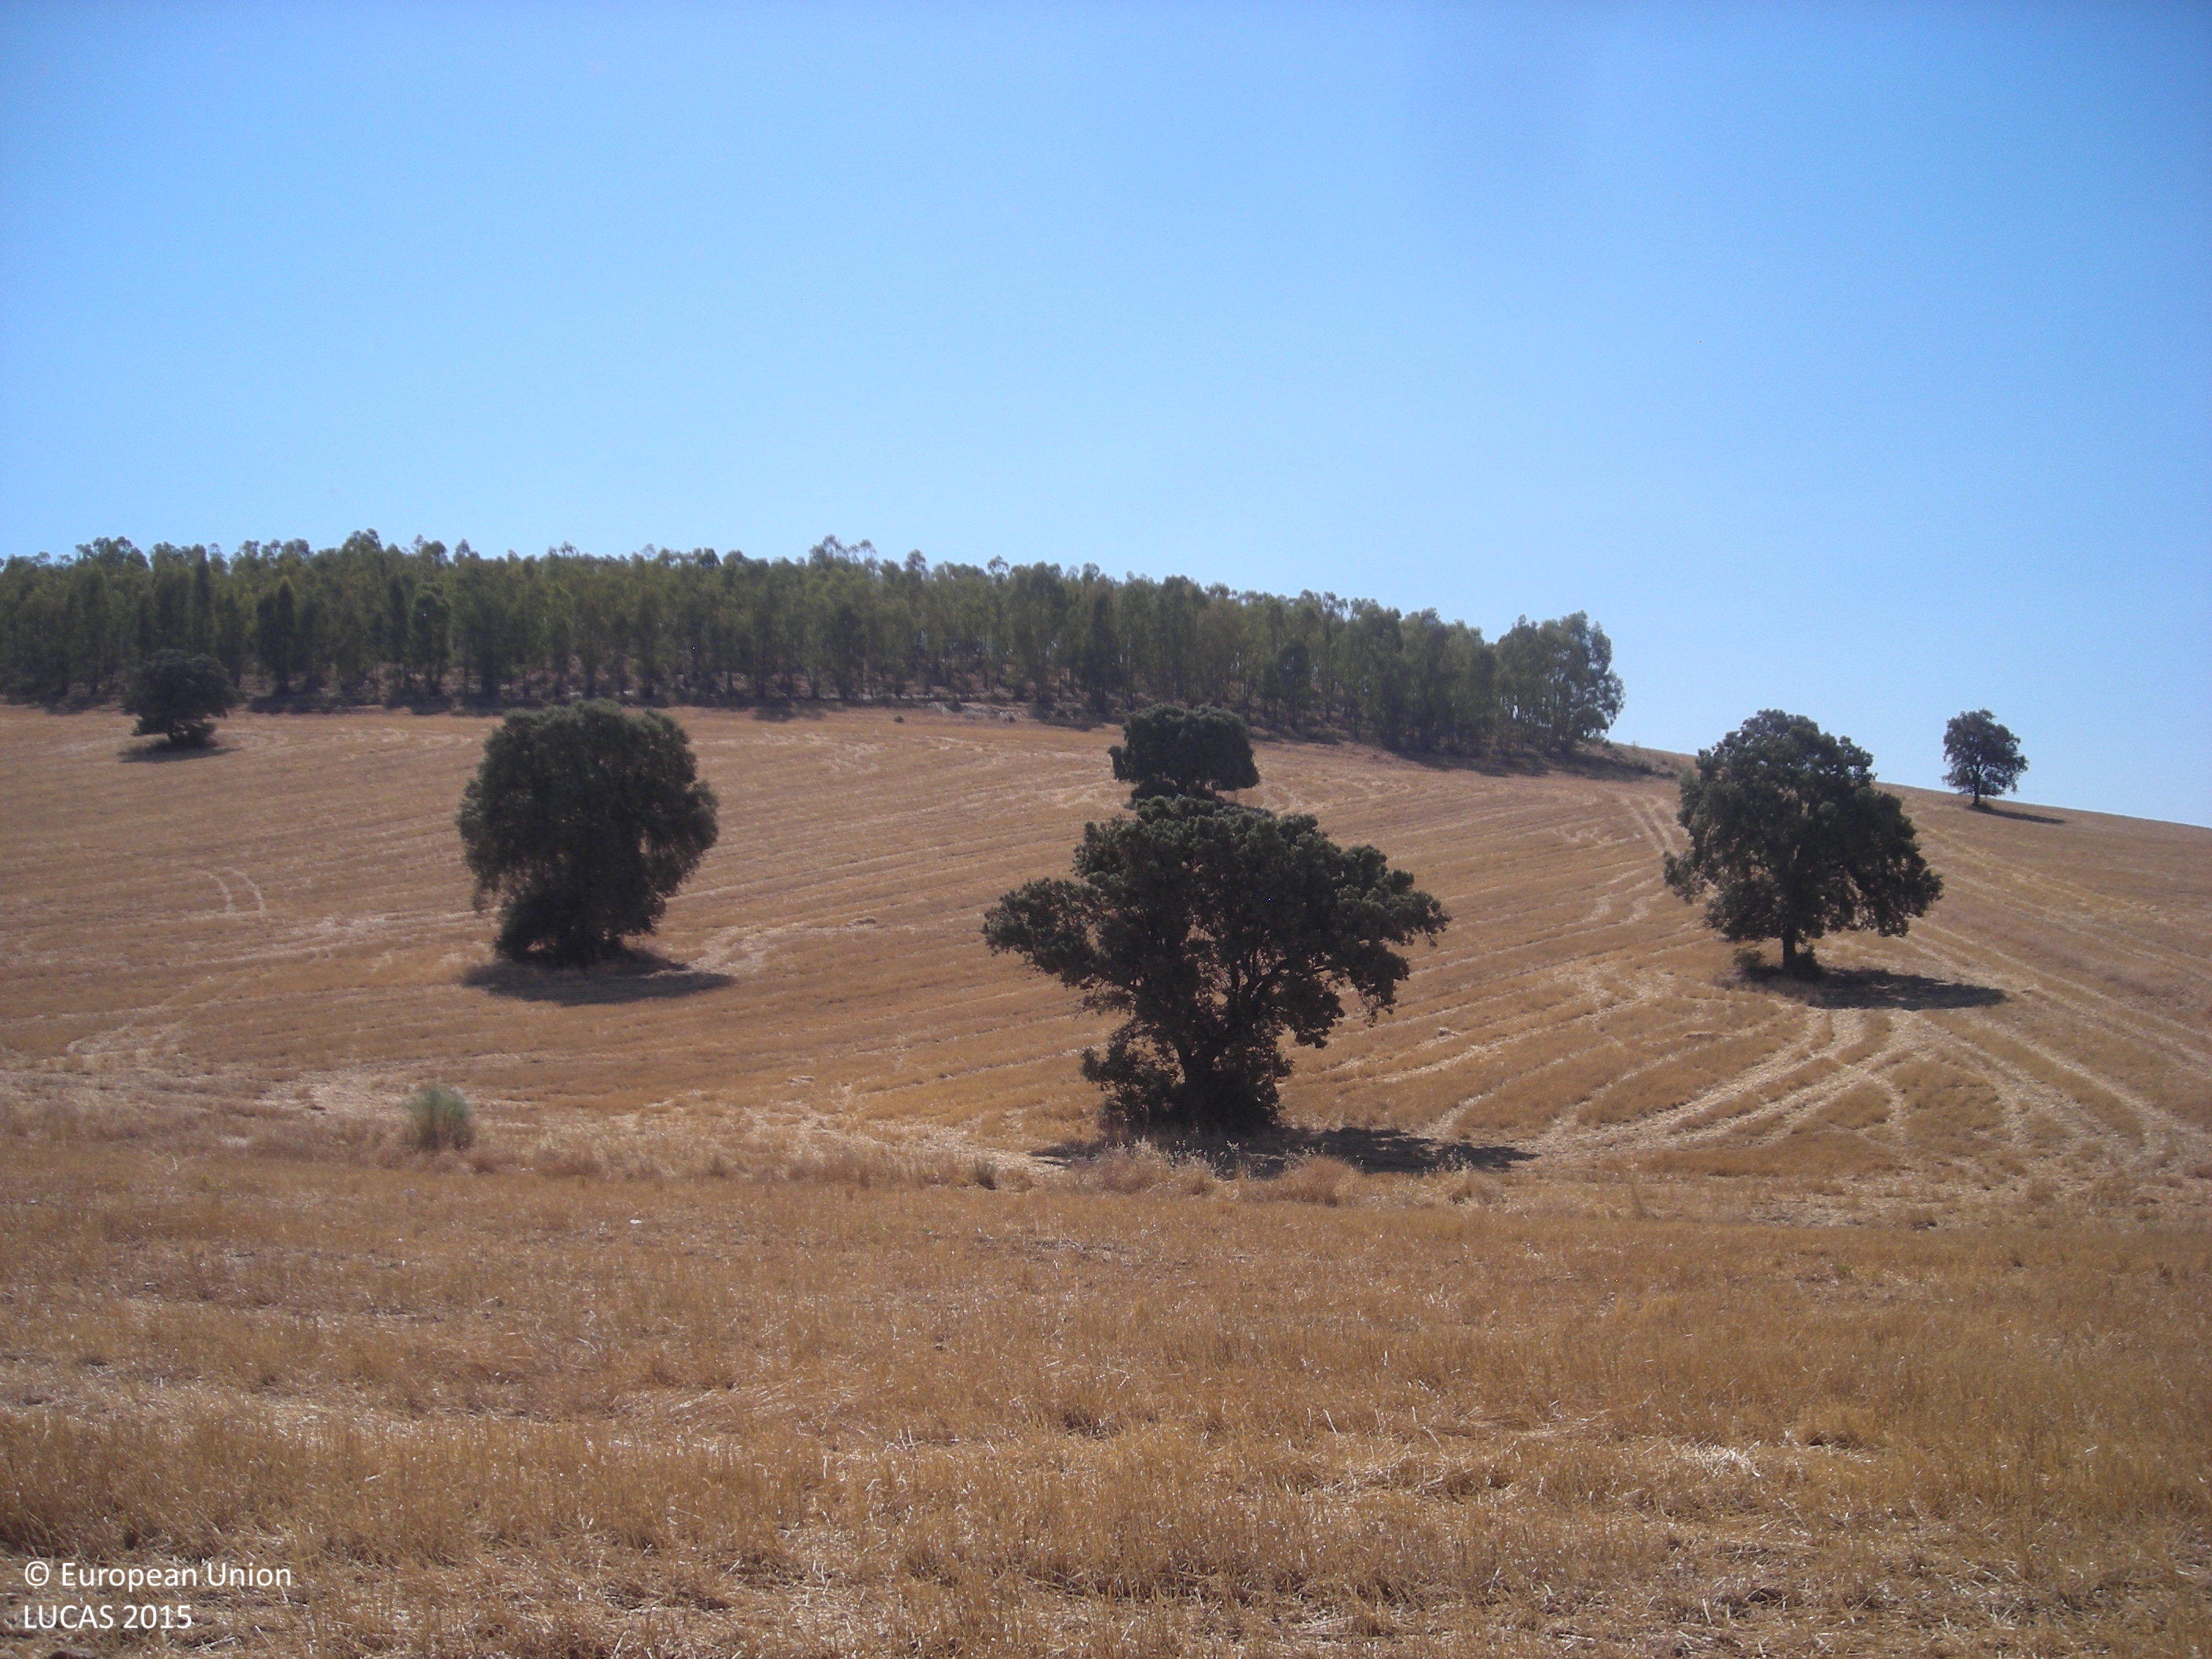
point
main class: Woodland
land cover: Broadleaved woodland
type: broadleaved evergreen forest
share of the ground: > 75 %
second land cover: Grassland without tree/shrub cover
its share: 10 - 25 %
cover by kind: broadleaved forest trees 85 %, herbaceous plants 15 %
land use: Forestry
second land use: Agriculture (excluding fallow land and kitchen gardens)
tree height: > 5 m
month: July
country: ES
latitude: 38.8523
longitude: -5.8919
